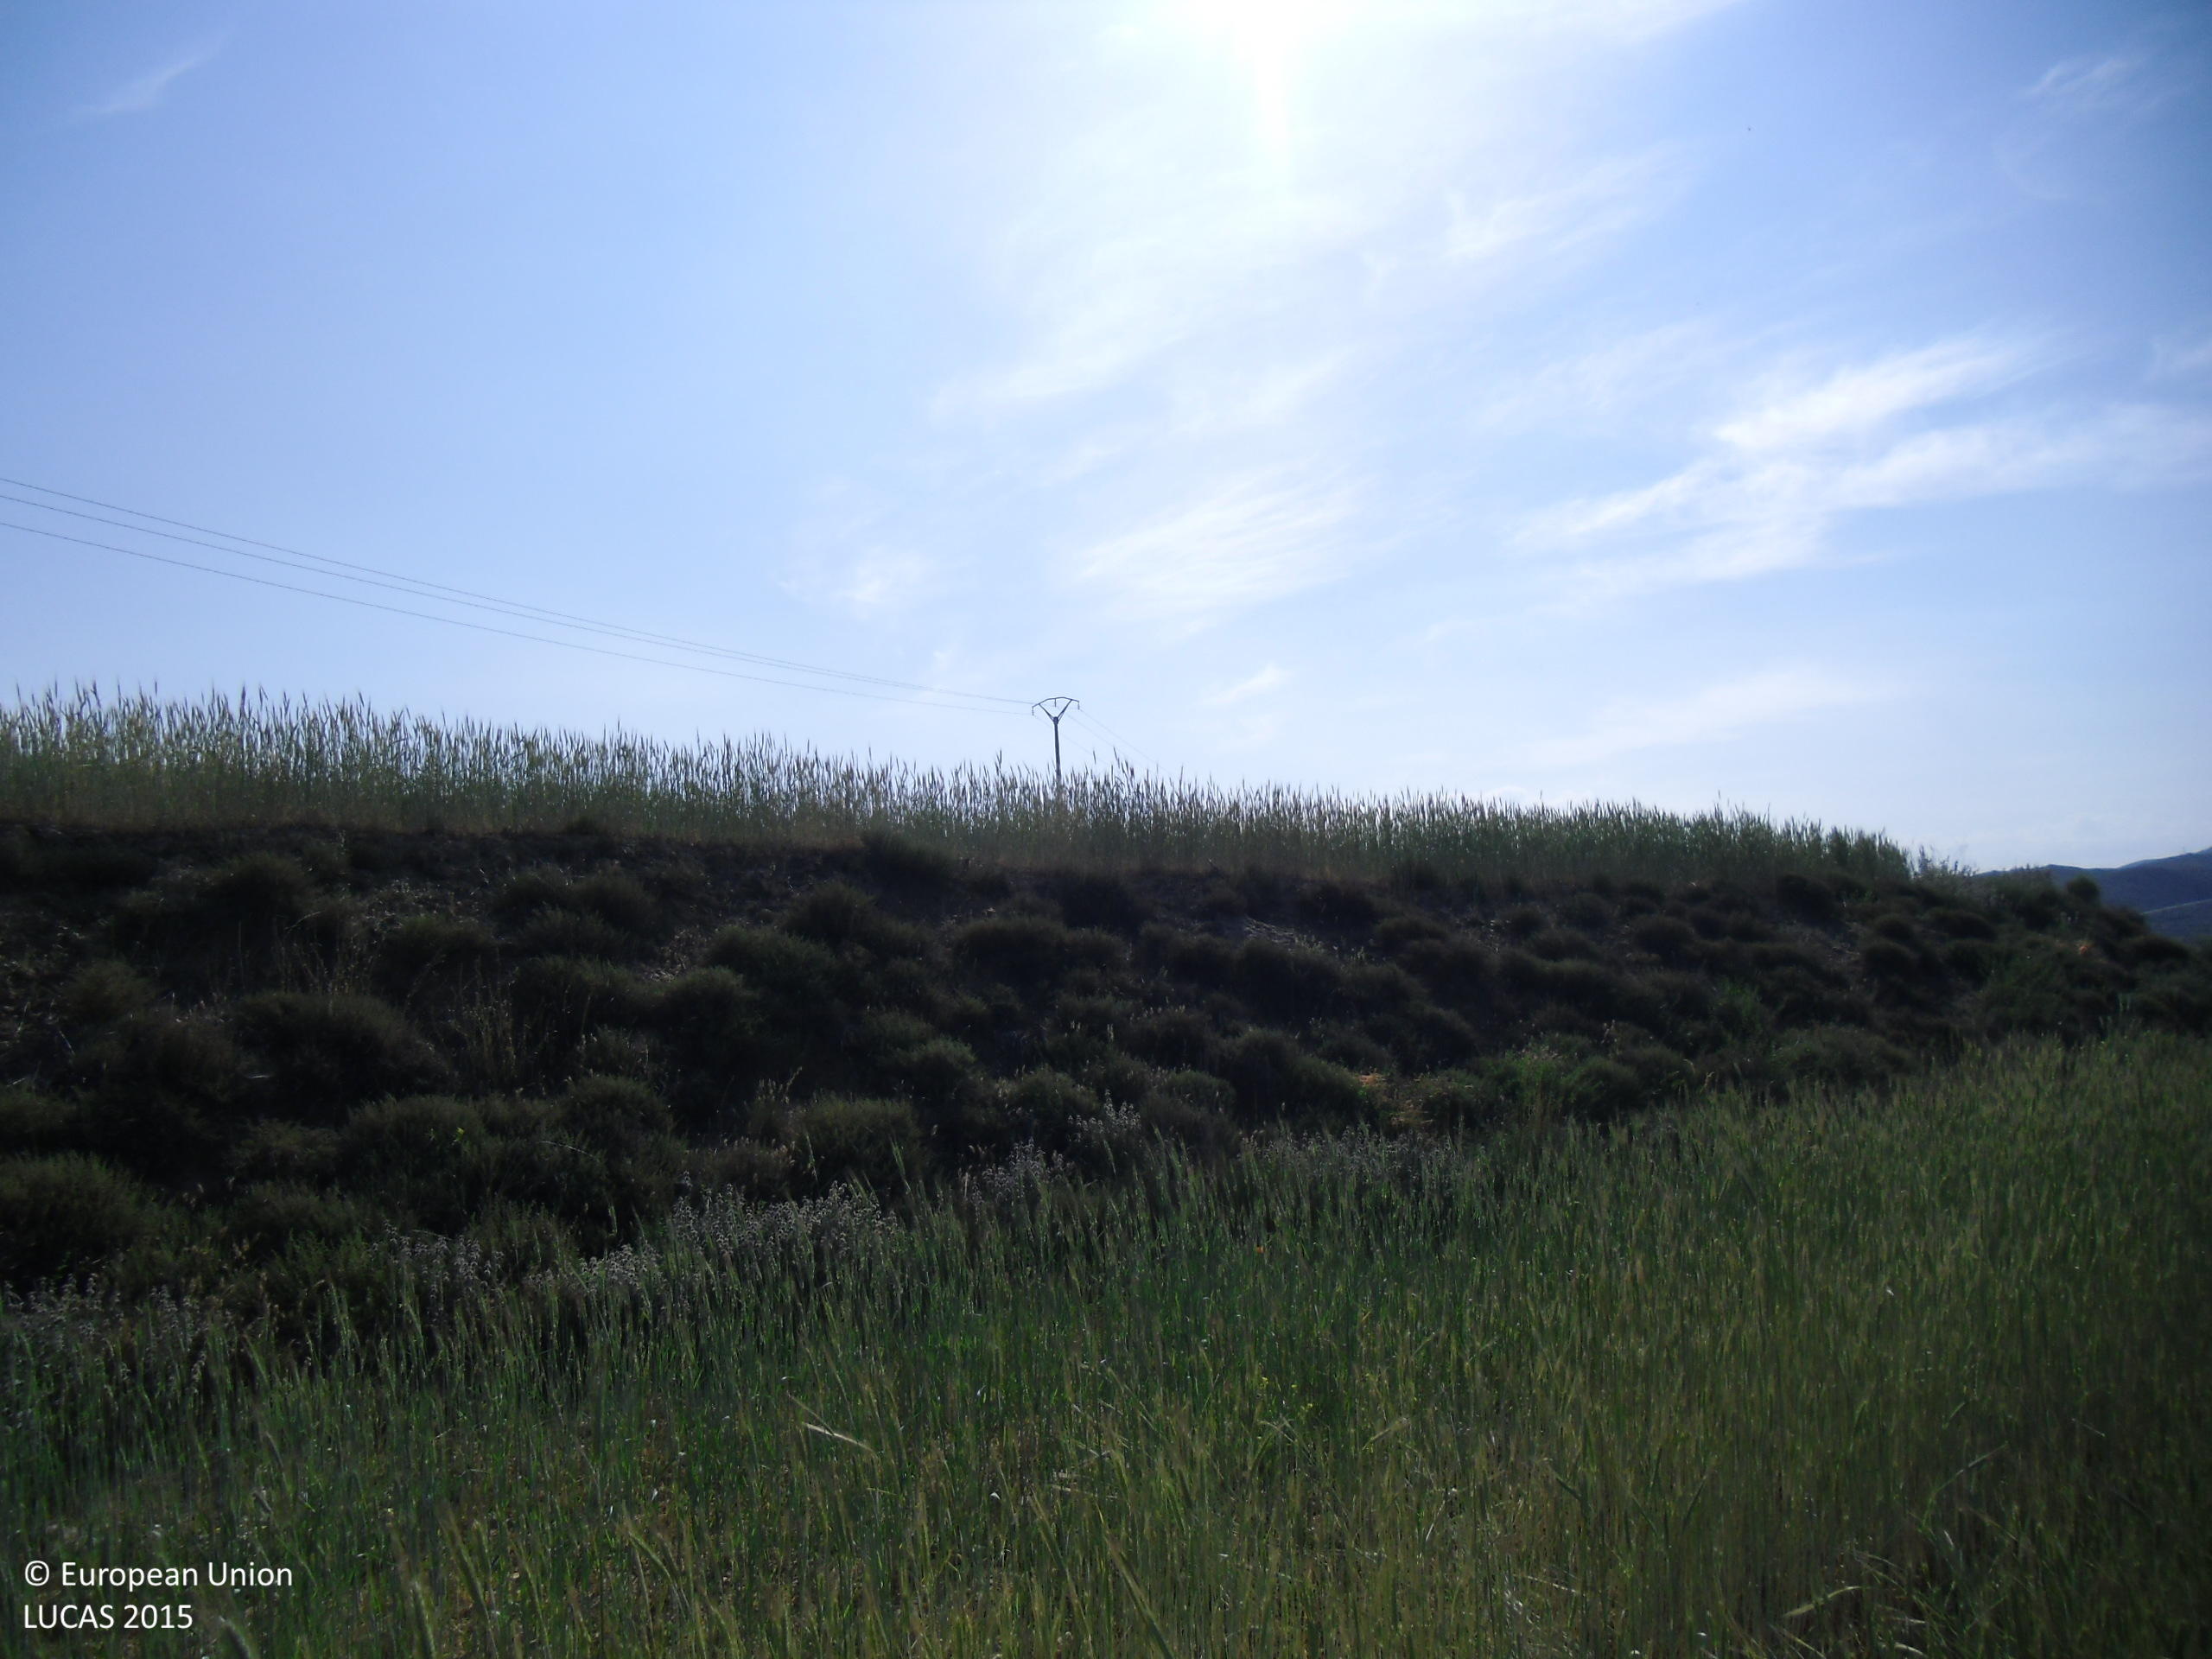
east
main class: Cropland
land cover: Rye
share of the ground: > 75 %
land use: Agriculture (excluding fallow land and kitchen gardens)
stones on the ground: < 10 %
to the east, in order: Rye; Grassland without tree/shrub cover; Rye; Grassland without tree/shrub cover; Tracks; Rye; Electric lines; Grassland without tree/shrub cover; Rye; Grassland without tree/shrub cover; Nuts trees
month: May
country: ES
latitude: 40.7986
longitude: -0.8108
